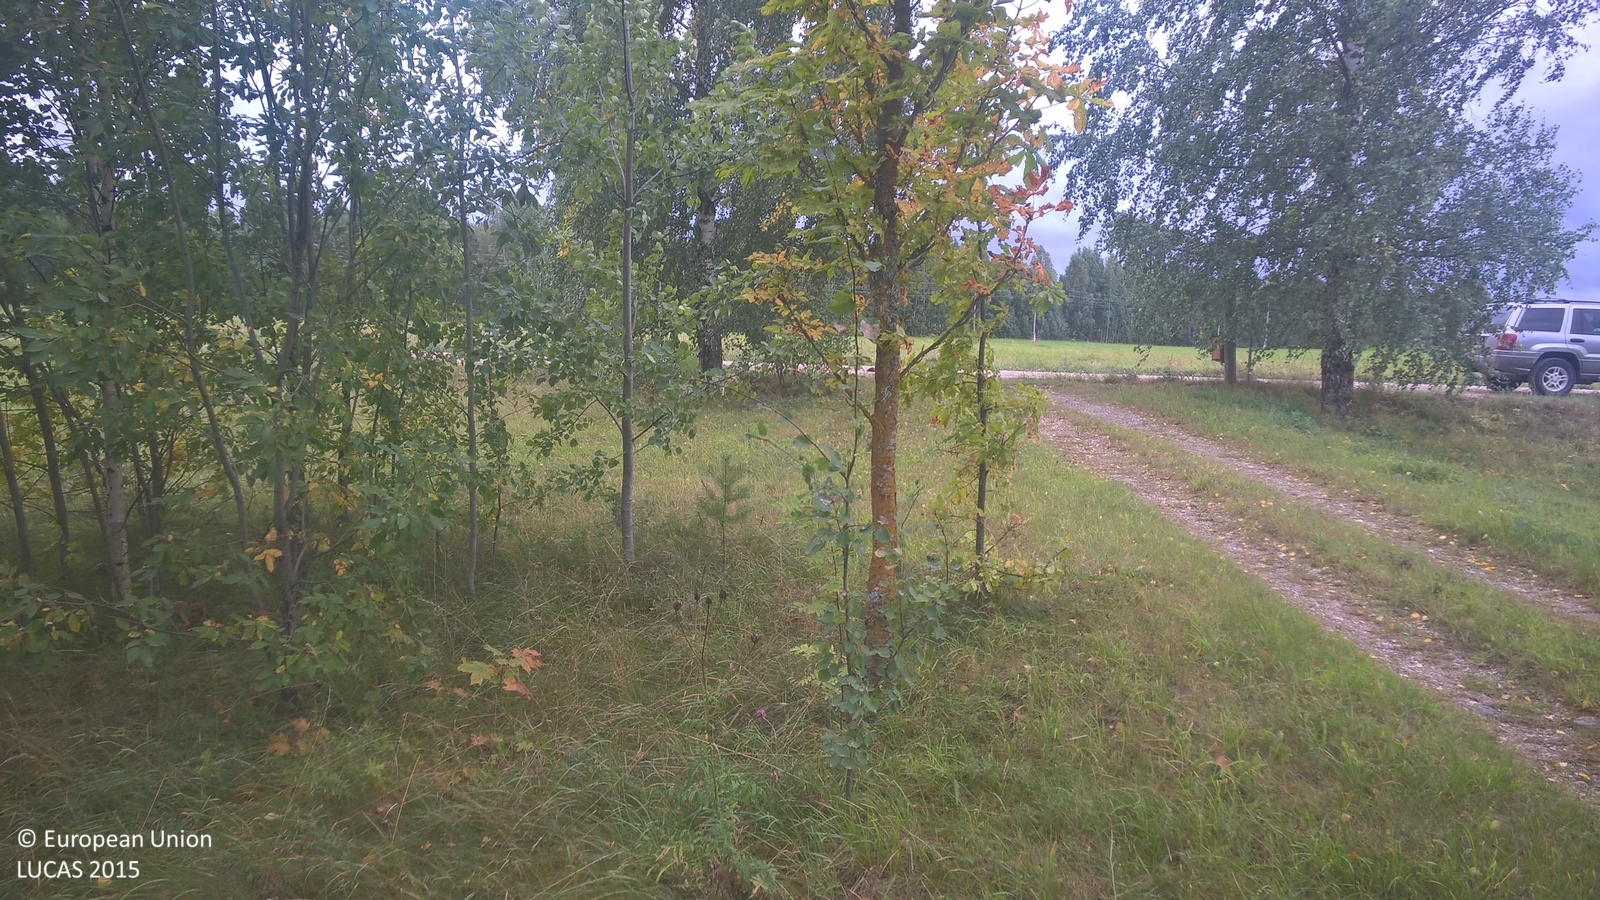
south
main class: Woodland
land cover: Broadleaved woodland
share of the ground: 10 - 25 %
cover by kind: herbaceous plants 70 %, broadleaved forest trees 20 %, shrubs 5 %, lichens and mosses 5 %
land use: Forestry
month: September
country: LV
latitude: 57.4603
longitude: 25.9461
